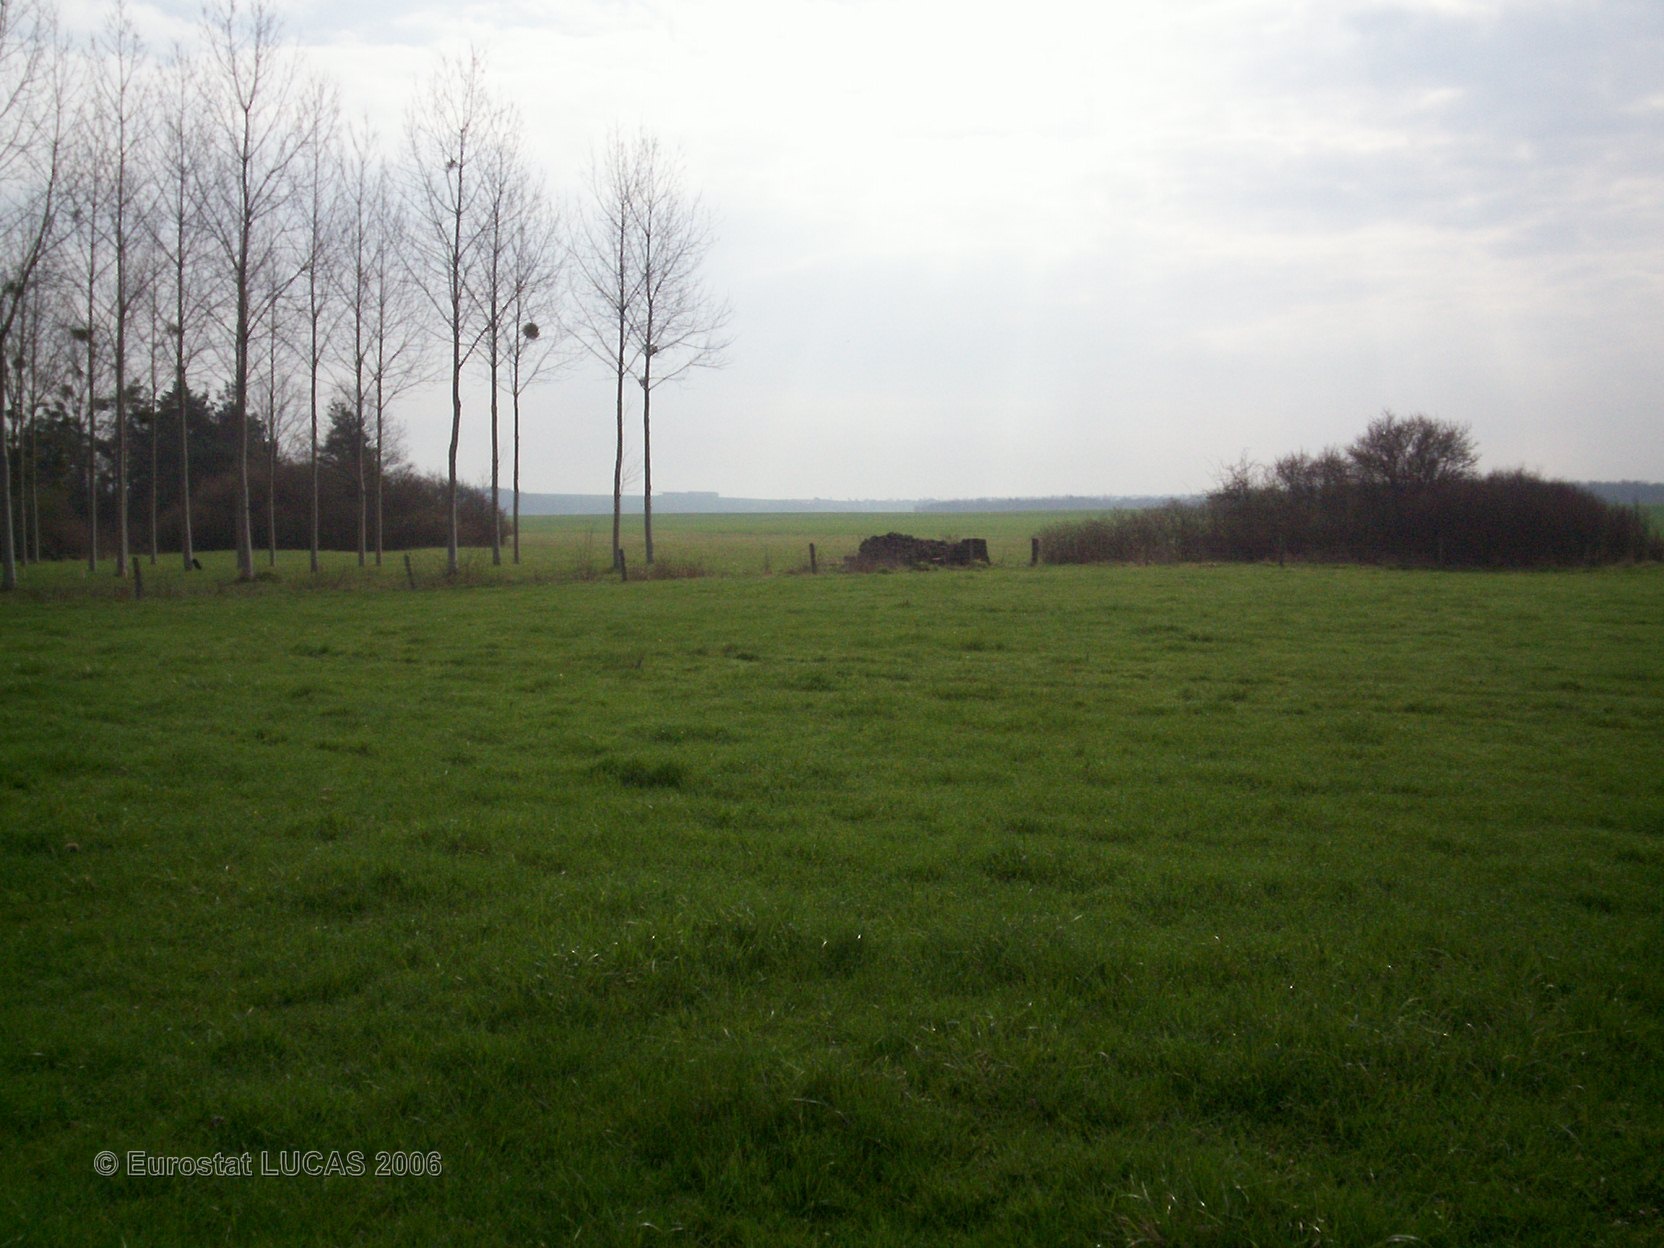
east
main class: Grassland
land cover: Grassland without tree/shrub cover
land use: Agriculture (excluding fallow land and kitchen gardens)
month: April
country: FR
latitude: 48.8139
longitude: 5.9005
